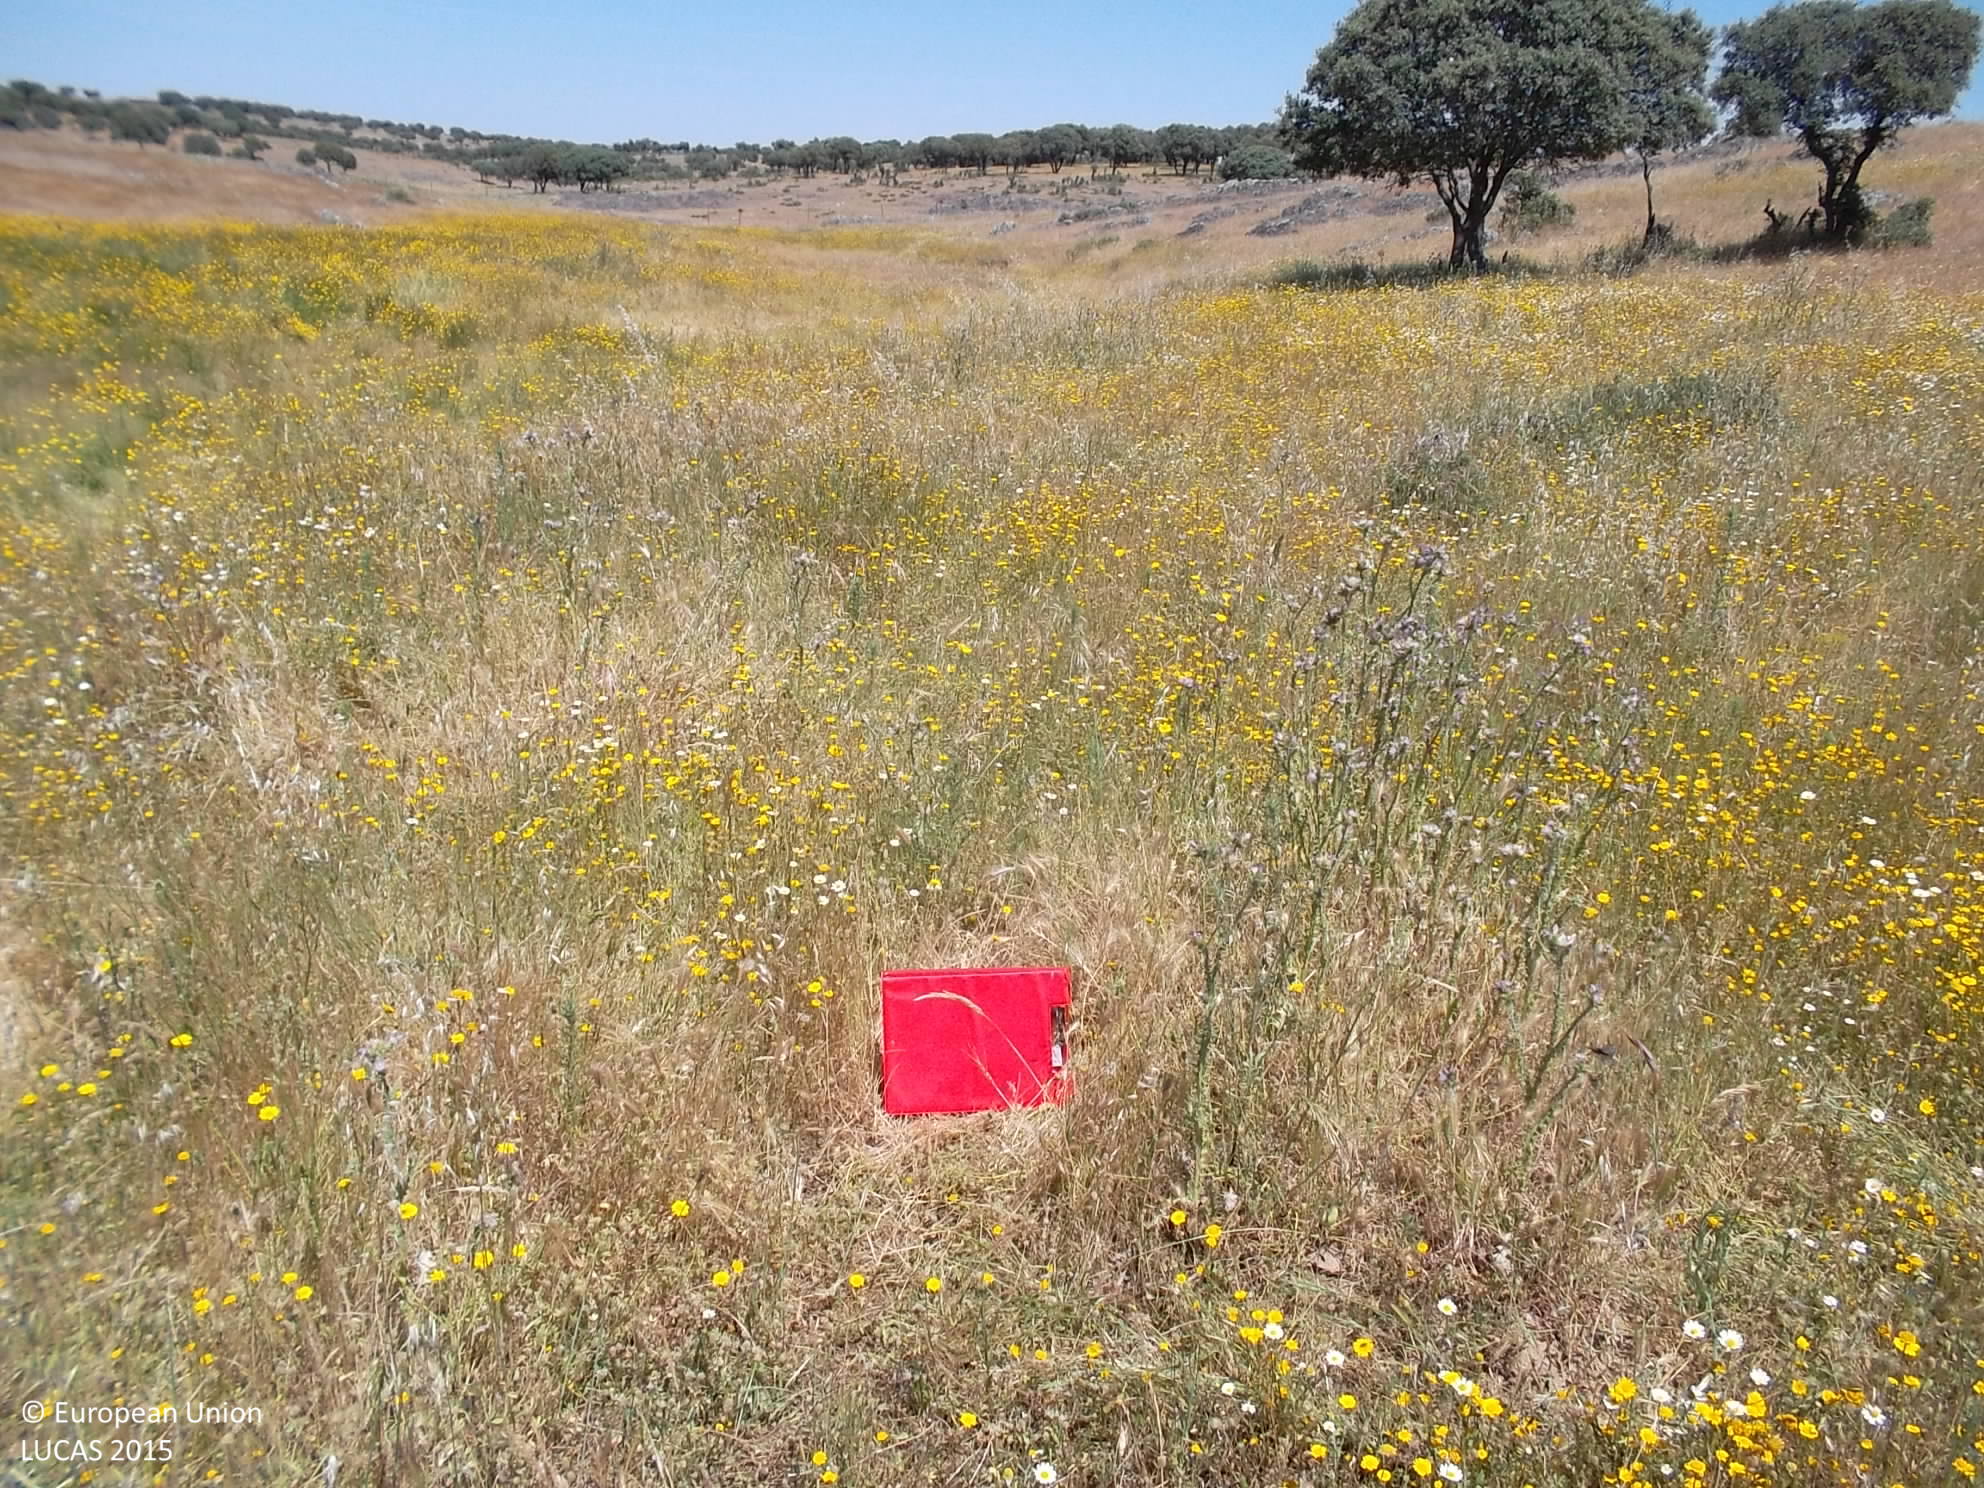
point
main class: Grassland
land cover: Grassland with sparse tree/shrub cover
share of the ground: > 75 %
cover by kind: herbaceous plants 95 %, broadleaved forest trees 5 %
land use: Agriculture (excluding fallow land and kitchen gardens)
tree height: > 5 m
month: May
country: ES
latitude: 38.8621
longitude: -4.4423
